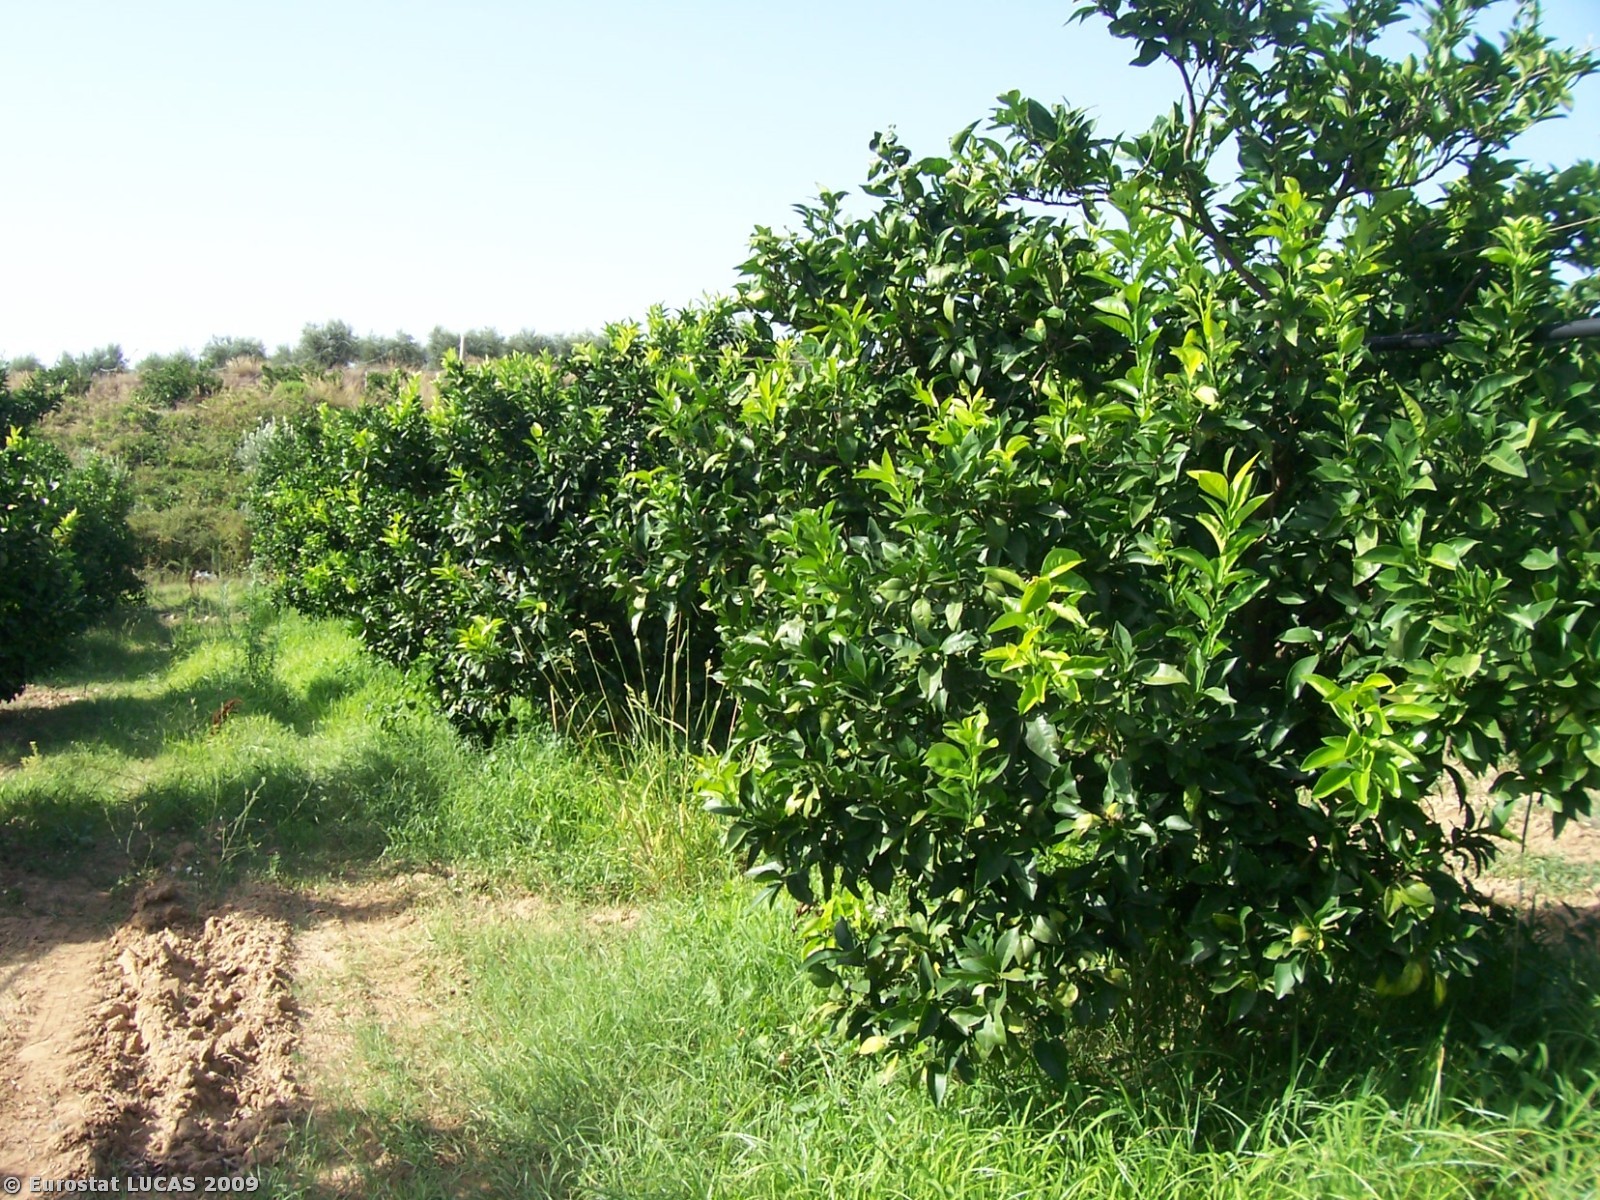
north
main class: Cropland
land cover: Oranges
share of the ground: 50 - 75 %
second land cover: Spontaneously vegetated surfaces
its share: > 75 %
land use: Agriculture (excluding fallow land and kitchen gardens)
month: July
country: IT
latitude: 40.5829
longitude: 16.9585
